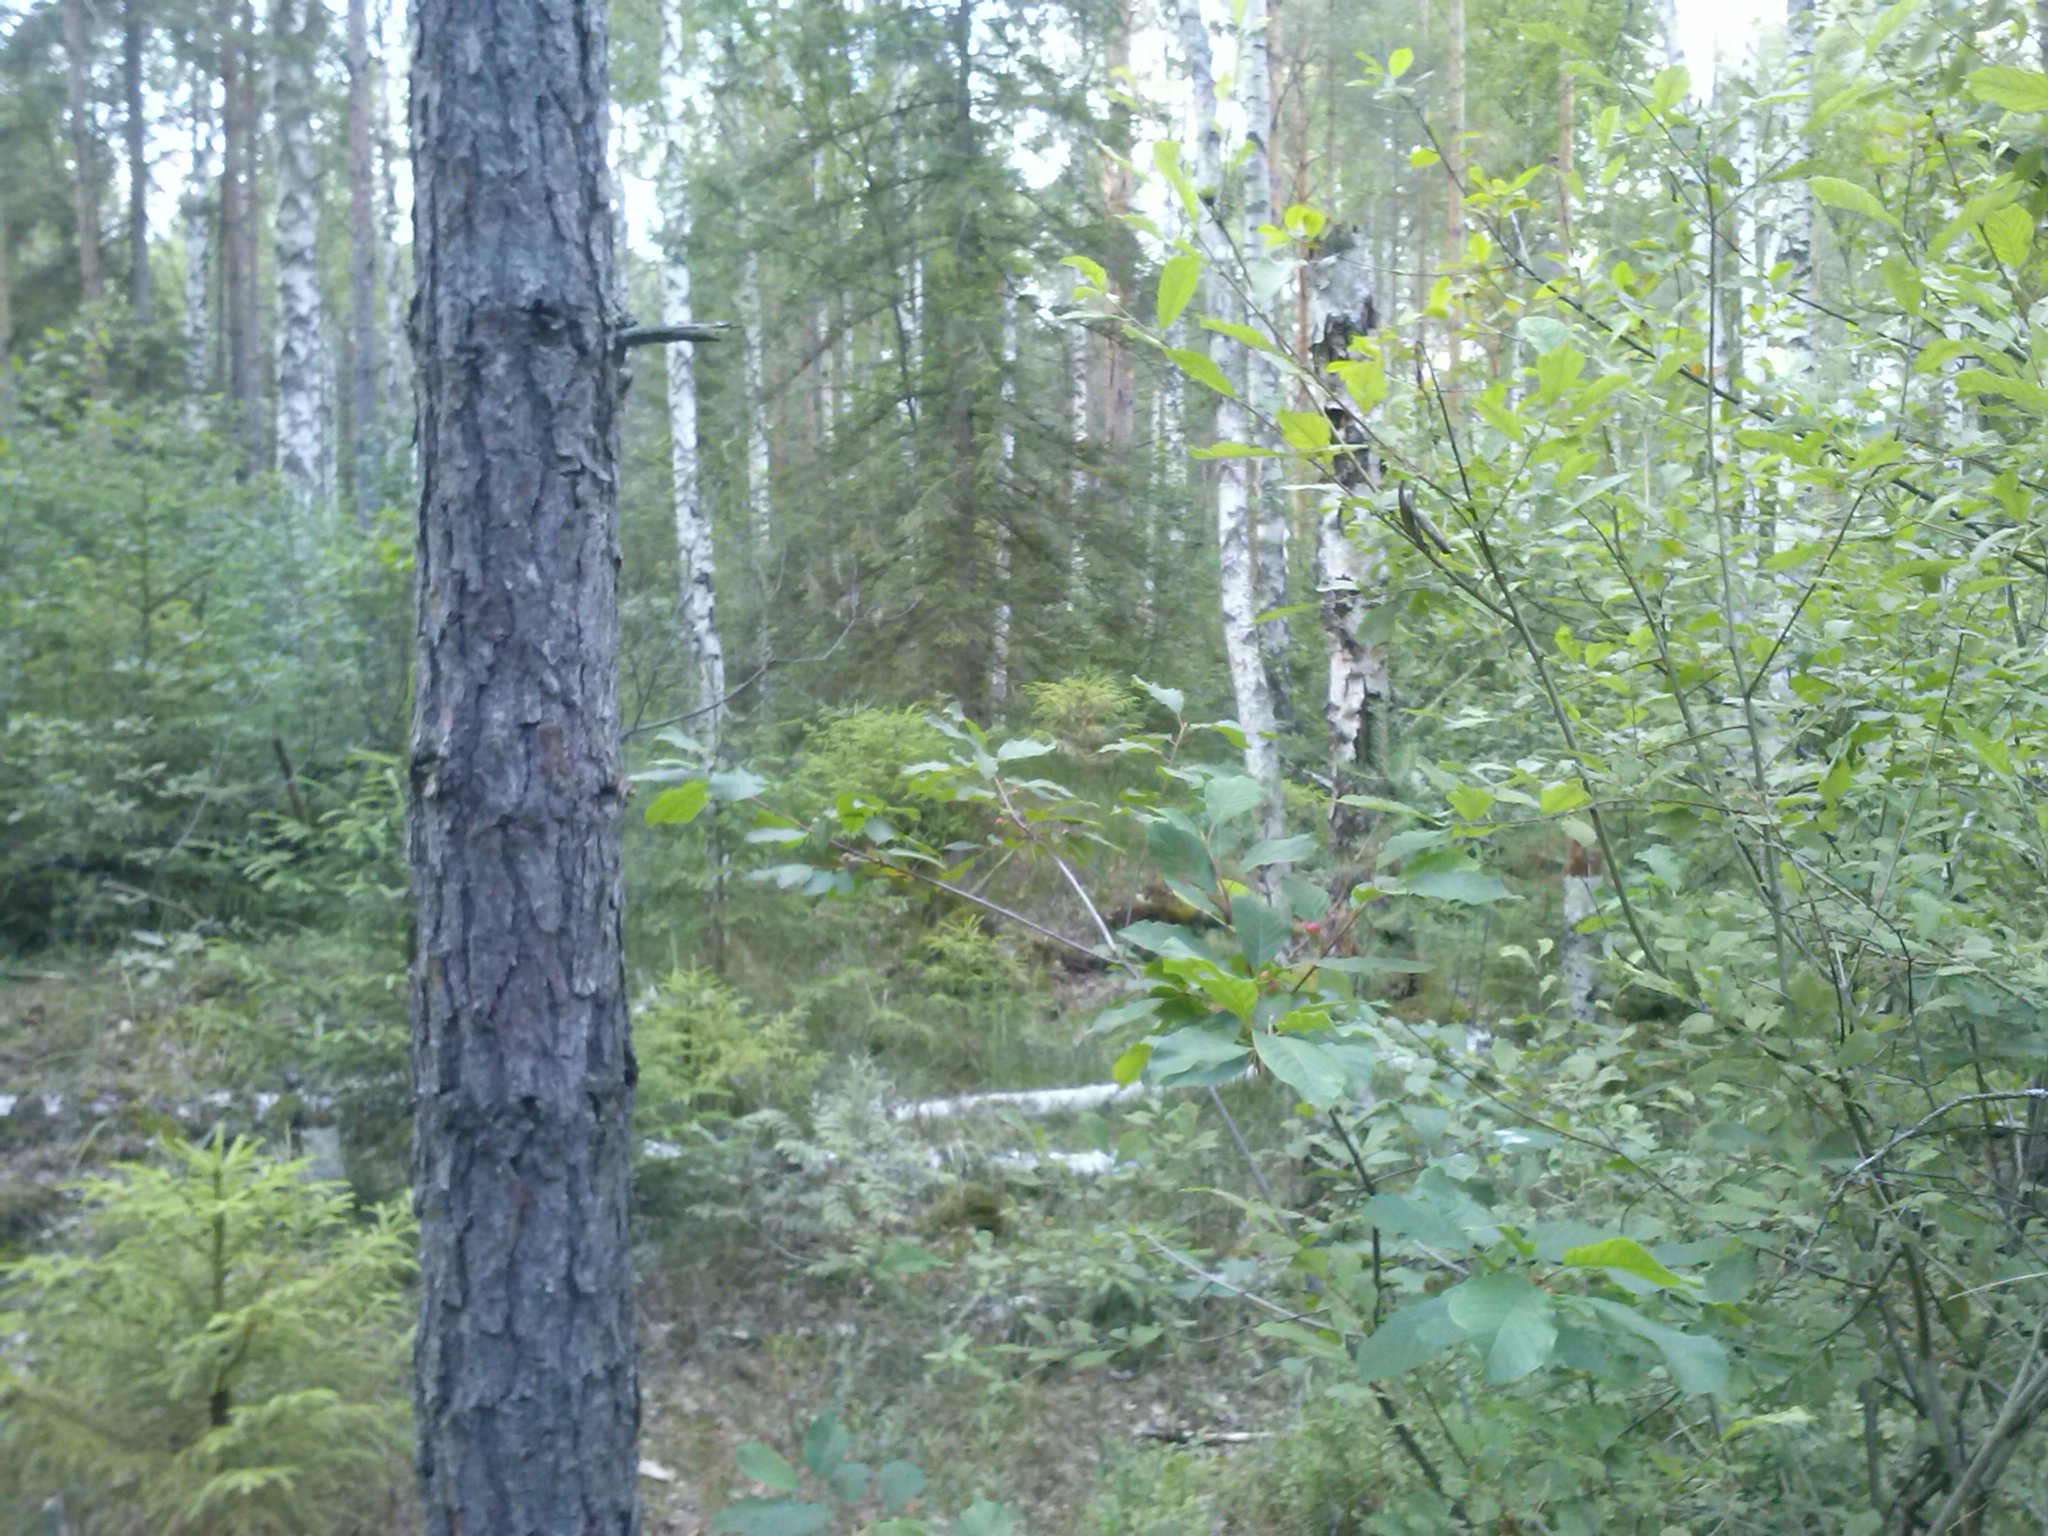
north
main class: Woodland
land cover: Spruce dominated mixed woodland
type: hemiboreal forest and nemoral coniferous forest and mixed broadleaved-coniferous forest
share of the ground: > 75 %
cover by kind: coniferous forest trees 50 %, broadleaved forest trees 30 %, herbaceous plants 20 %
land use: Forestry
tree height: > 5 m
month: July
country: LV
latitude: 56.8126
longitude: 27.7967
